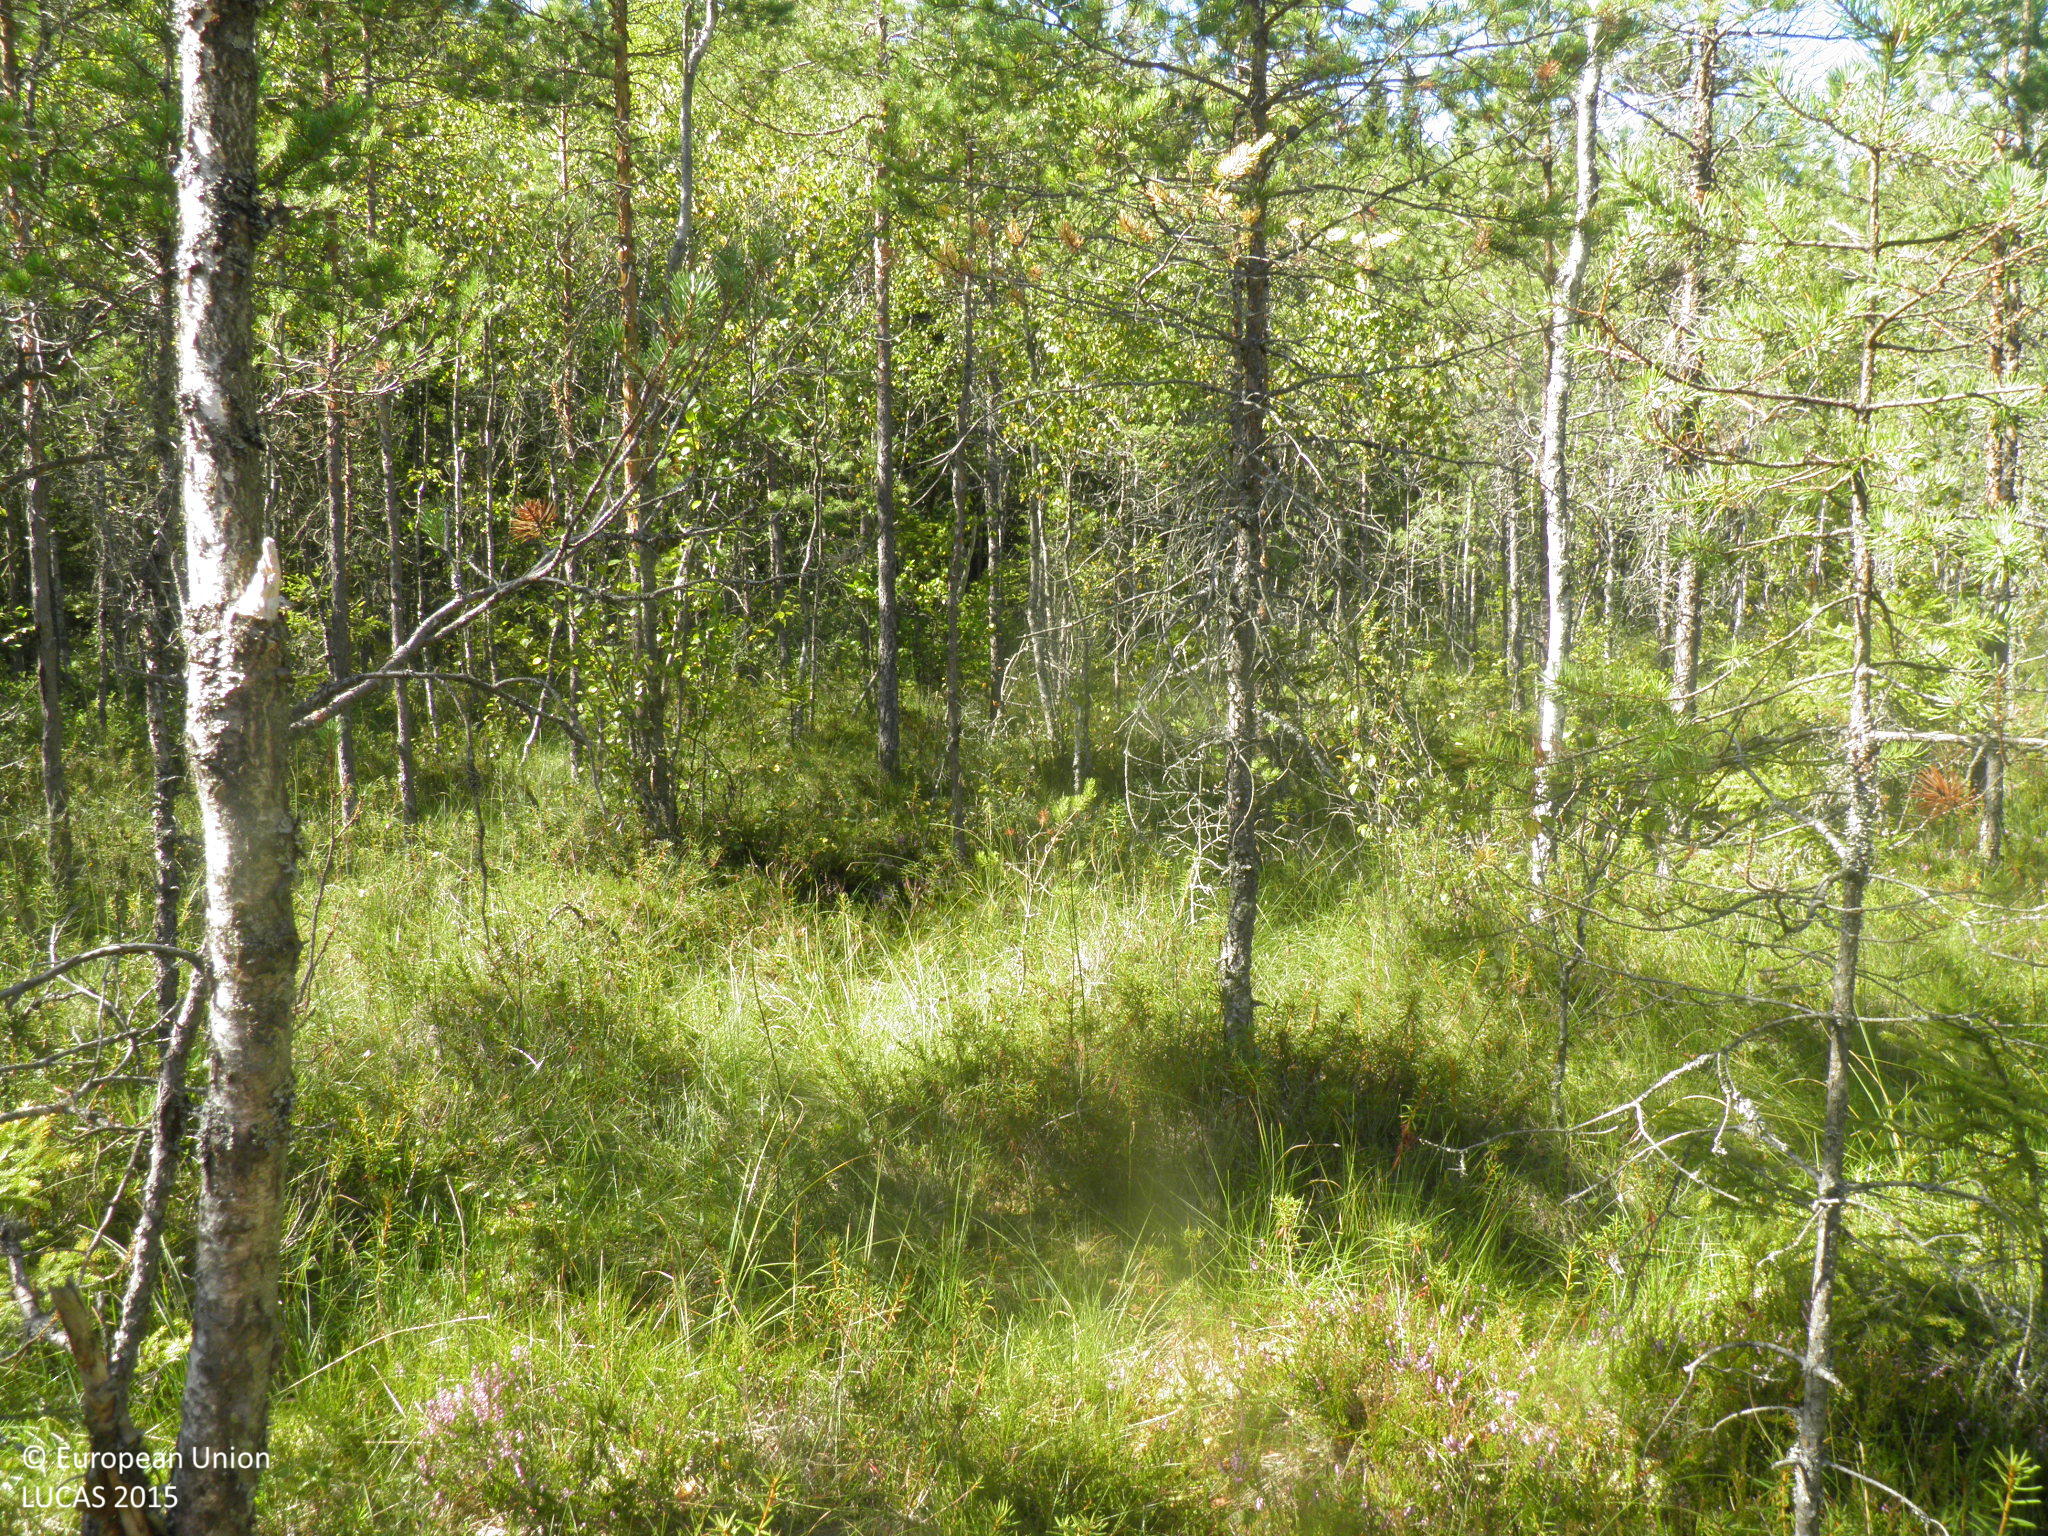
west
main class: Woodland
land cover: Pine dominated mixed woodland
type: mire and swamp forests
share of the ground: 25 - 50 %
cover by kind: coniferous forest trees 30 %, shrubs 30 %, lichens and mosses 20 %, broadleaved forest trees 10 %, herbaceous plants 10 %
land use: Semi-natural and natural areas not in use
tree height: < 5 m
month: August
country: FI
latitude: 60.8963
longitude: 21.4625
